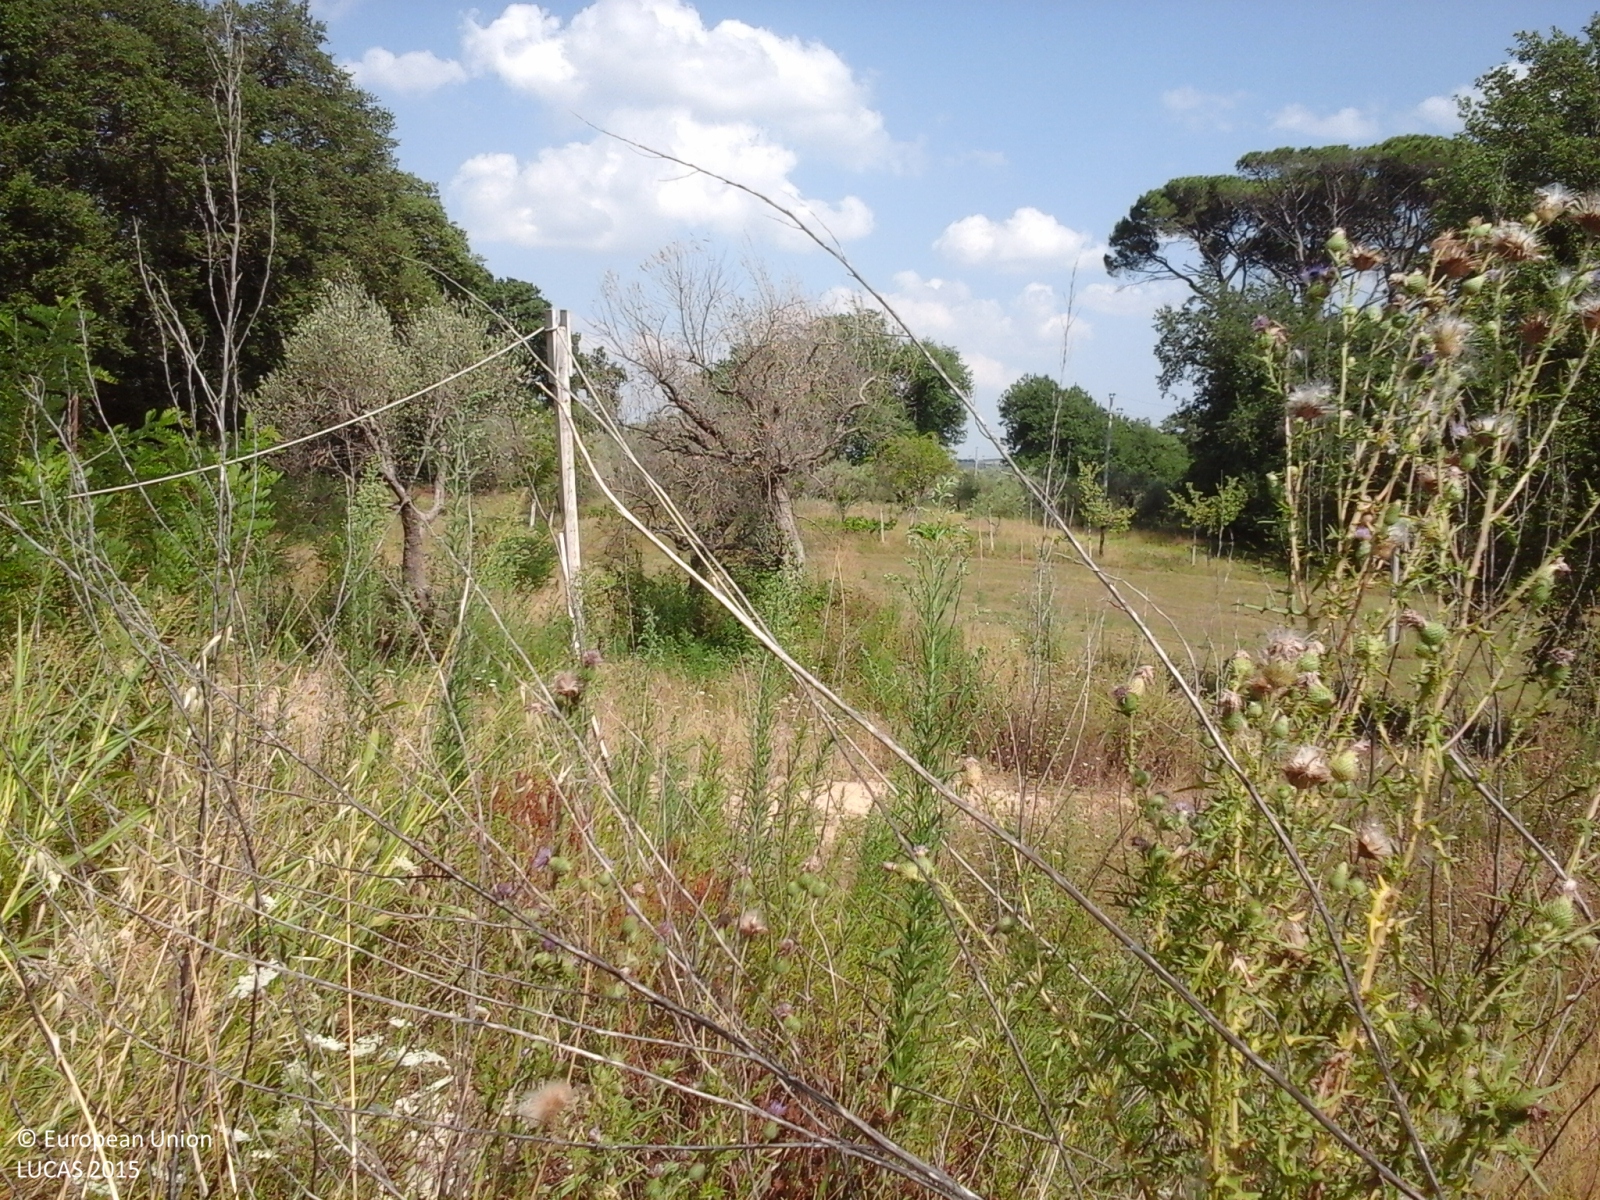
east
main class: Grassland
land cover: Spontaneously vegetated surfaces
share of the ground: > 75 %
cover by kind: herbaceous plants 95 %, shrubs 5 %
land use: Fallow land
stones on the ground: 10 - 25 %
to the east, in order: Spontaneously vegetated surfaces; Olive groves; Spontaneously vegetated surfaces; Broadleaved woodland; Temporary grasslands; Olive groves
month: August
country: IT
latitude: 43.2365
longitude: 13.1809
